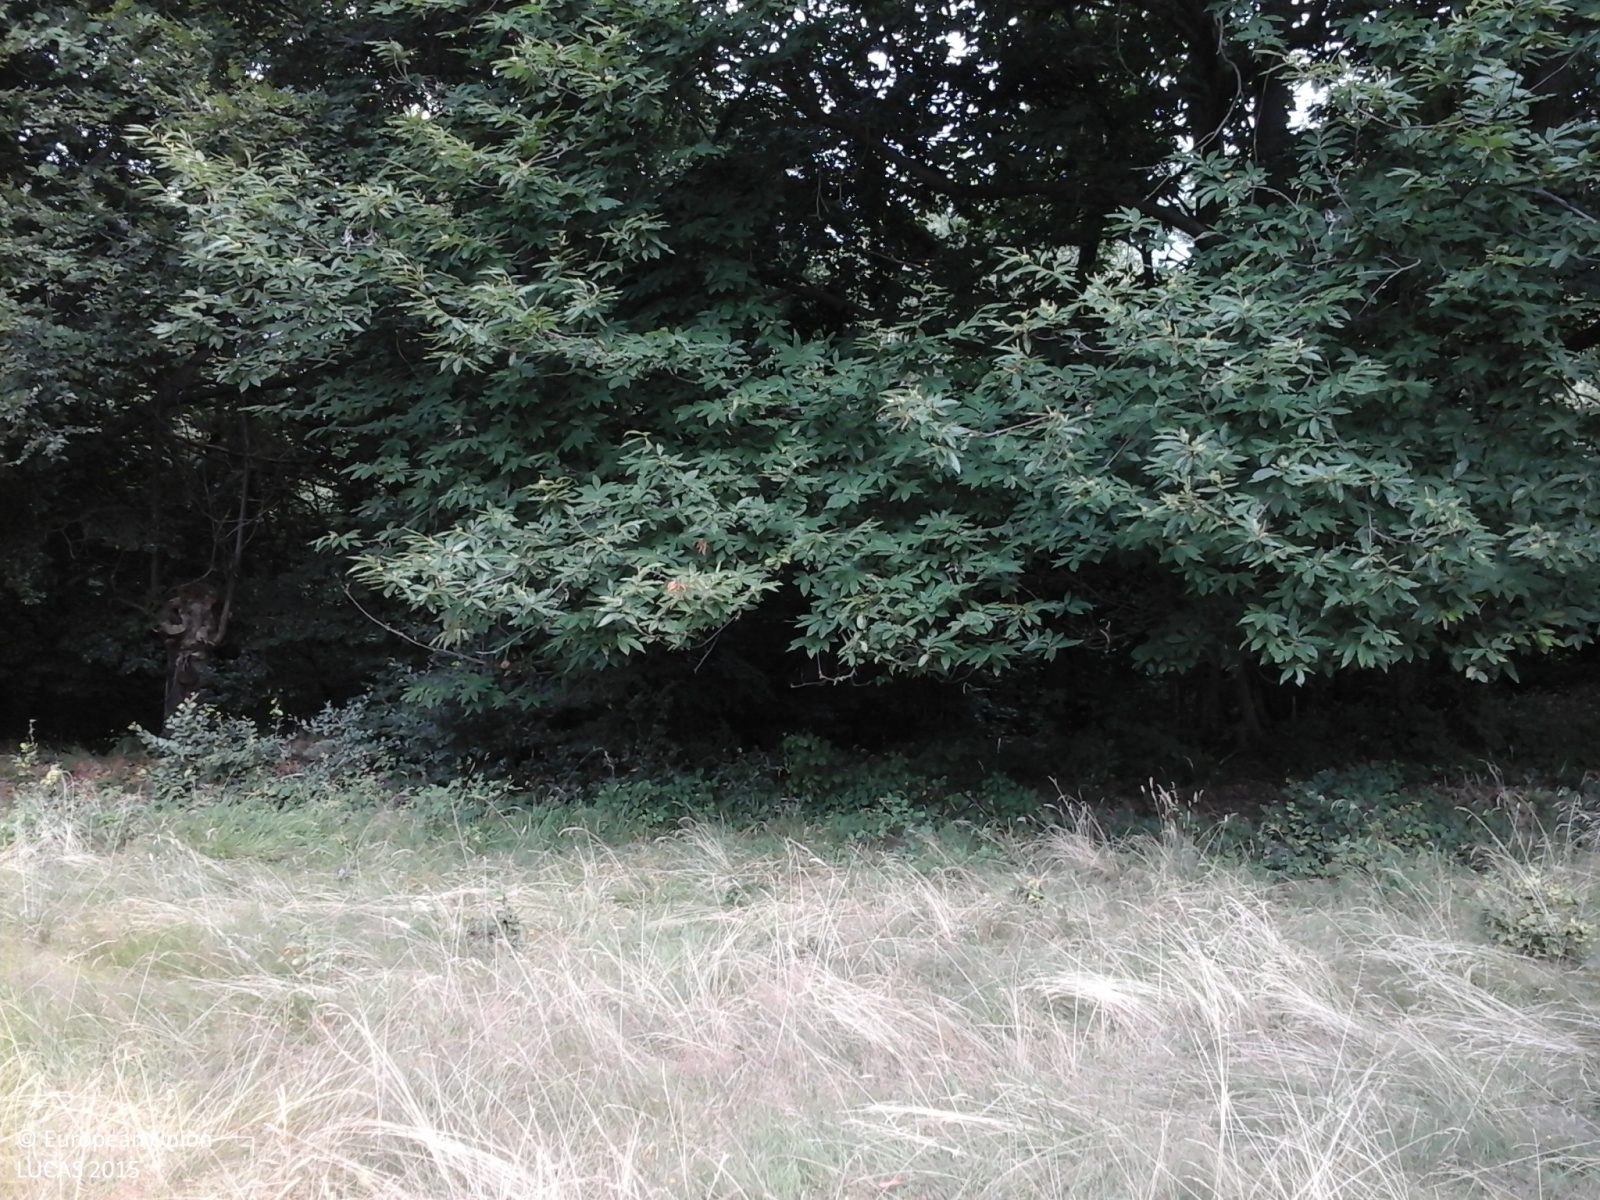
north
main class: Grassland
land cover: Grassland without tree/shrub cover
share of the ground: > 75 %
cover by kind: herbaceous plants 100 %
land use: Agriculture (excluding fallow land and kitchen gardens)
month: July
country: IT
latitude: 45.4813
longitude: 7.7902
